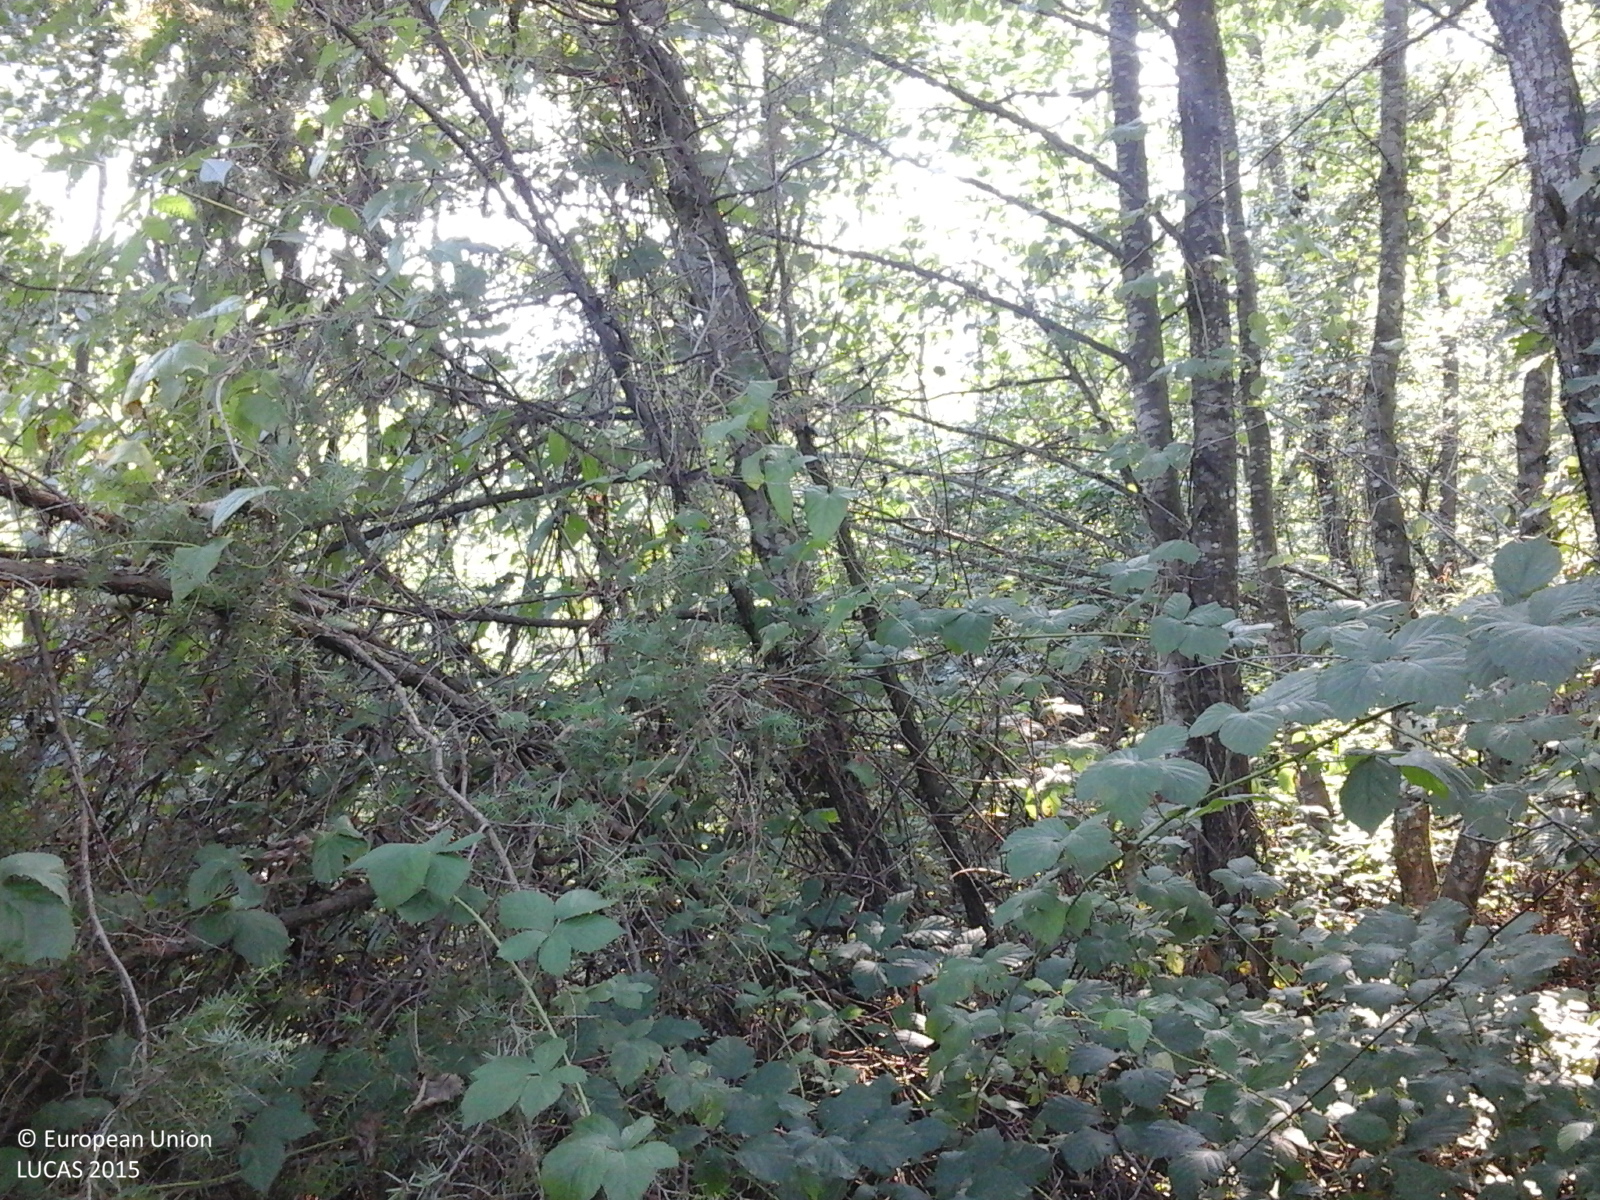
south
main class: Woodland
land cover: Other mixed woodland
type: beech forest
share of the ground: > 75 %
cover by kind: broadleaved forest trees 70 %, coniferous forest trees 30 %
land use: Forestry
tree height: > 5 m
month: August
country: RO
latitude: 46.3066
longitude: 22.5023
